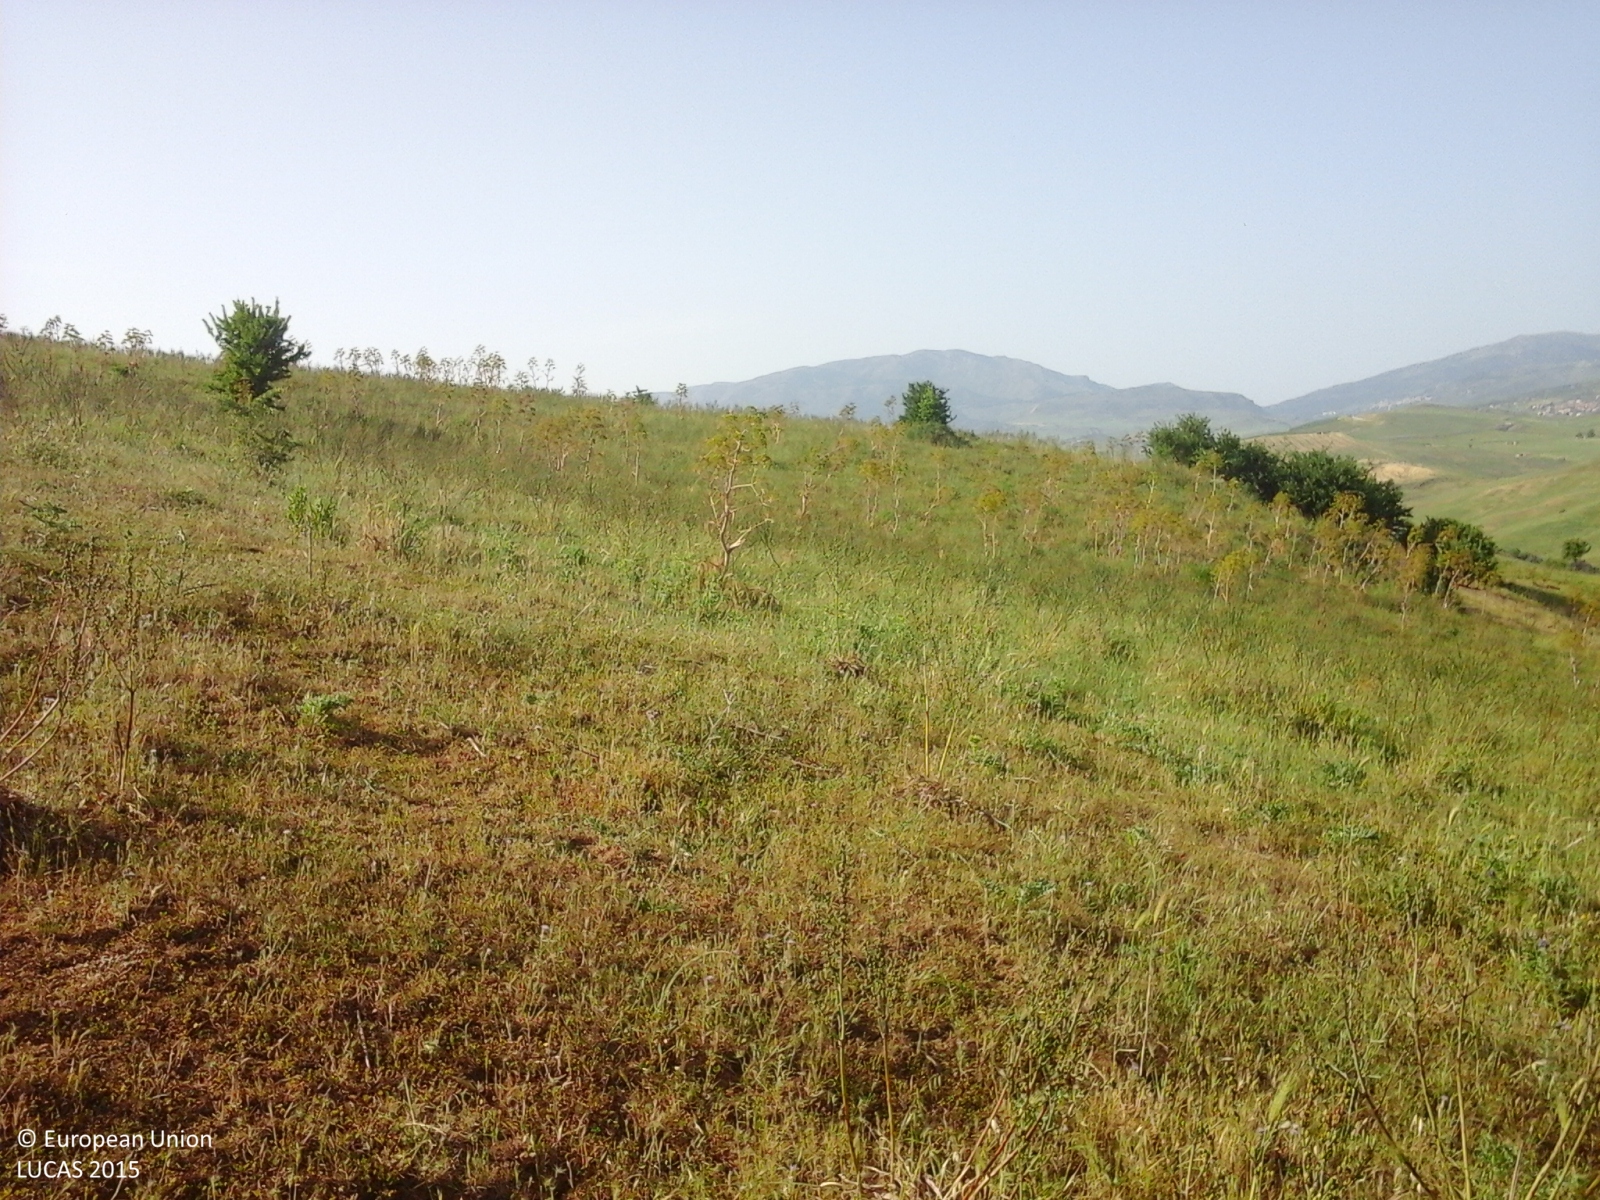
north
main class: Grassland
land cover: Grassland with sparse tree/shrub cover
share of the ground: > 75 %
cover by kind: herbaceous plants 90 %, broadleaved forest trees 5 %, shrubs 5 %
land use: Agriculture (excluding fallow land and kitchen gardens)
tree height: < 5 m
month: May
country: IT
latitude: 37.6979
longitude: 14.0422
